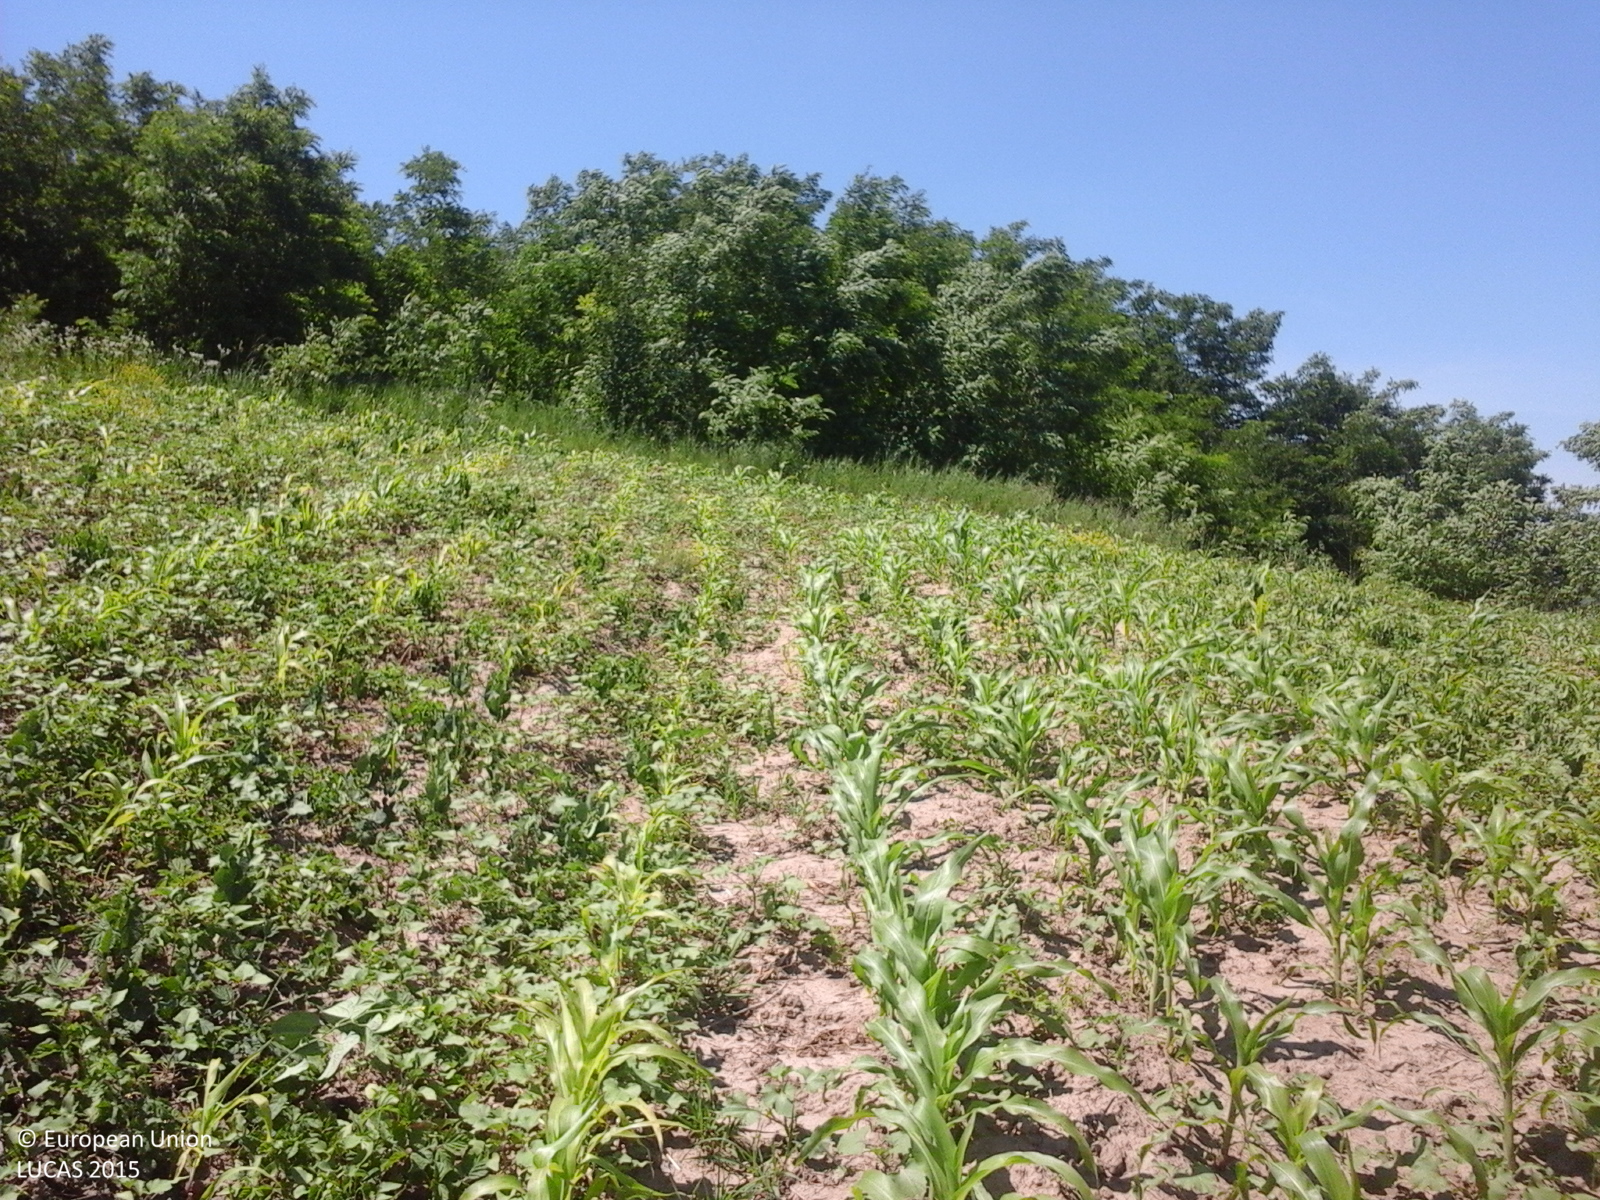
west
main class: Cropland
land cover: Maize
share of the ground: 25 - 50 %
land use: Agriculture (excluding fallow land and kitchen gardens)
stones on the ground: < 10 %
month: June
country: RO
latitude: 47.8653
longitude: 26.8788
